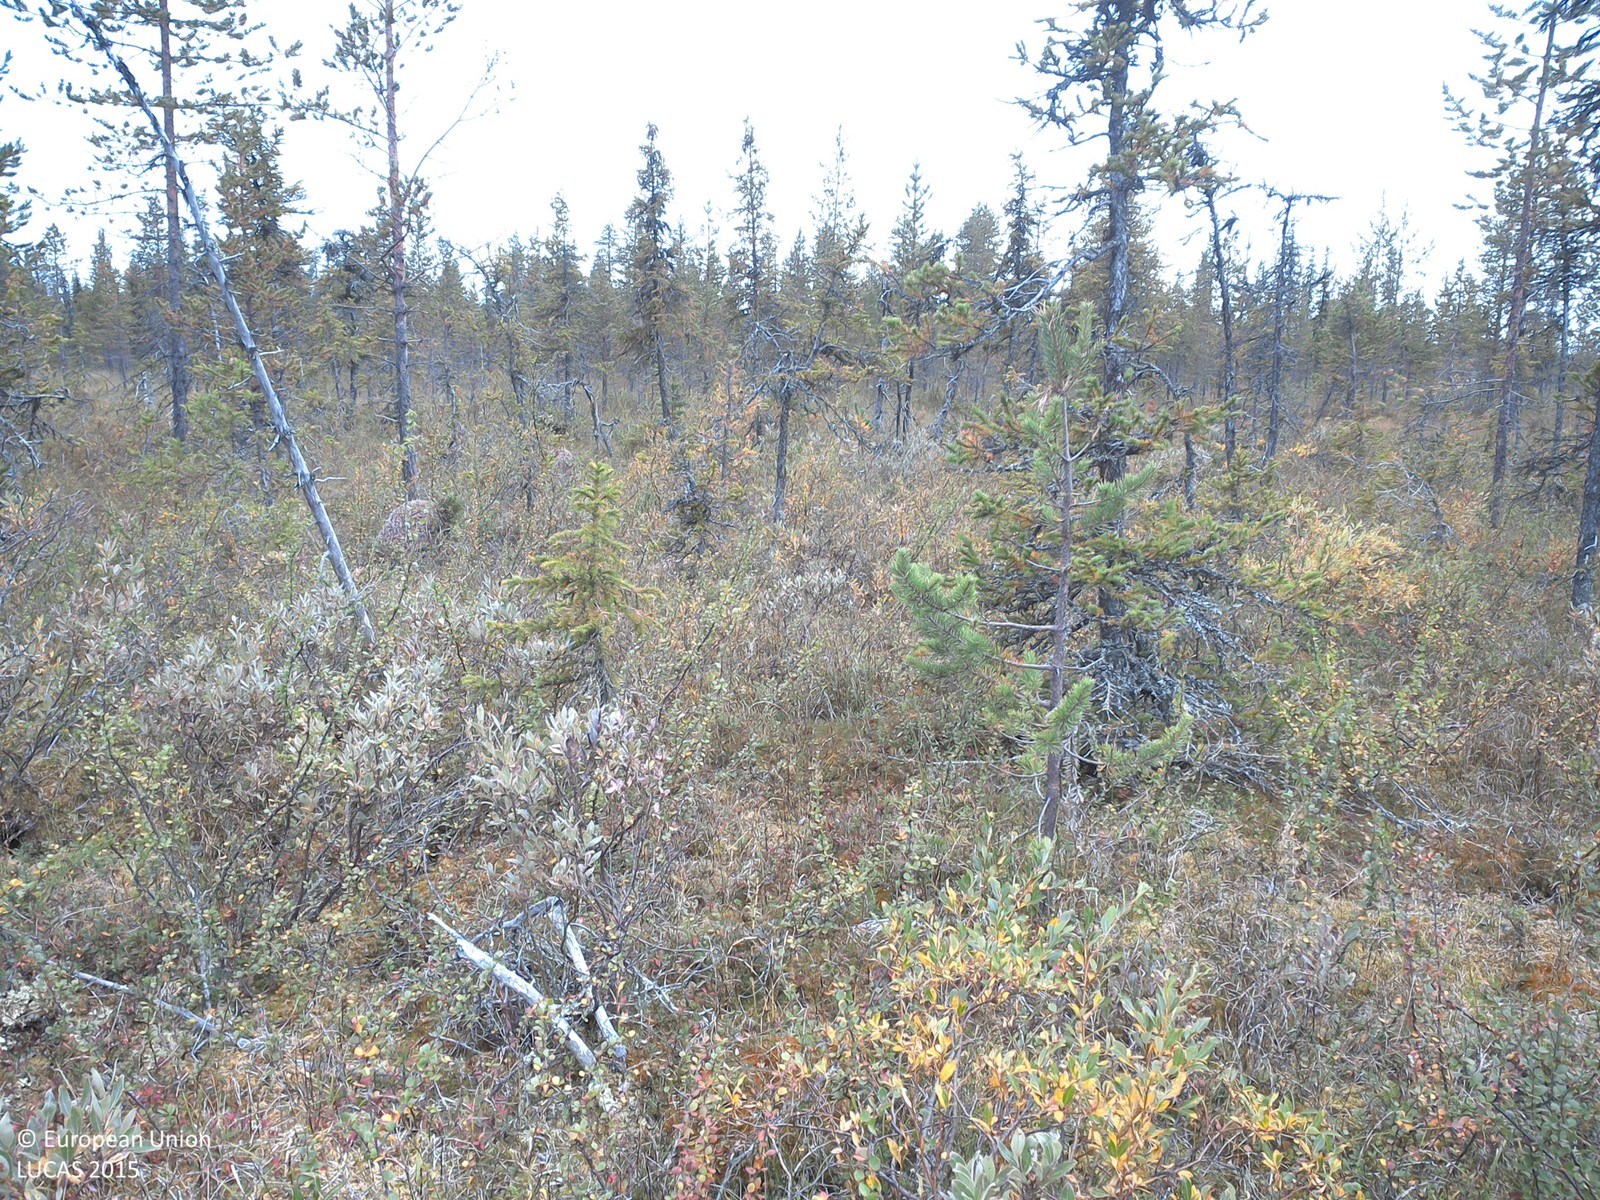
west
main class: Woodland
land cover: Spruce dominated coniferous woodland
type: boreal forest
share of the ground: 10 - 25 %
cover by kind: shrubs 65 %, lichens and mosses 20 %, coniferous forest trees 15 %
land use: Semi-natural and natural areas not in use
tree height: > 5 m
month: August
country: SE
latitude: 67.8384
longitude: 21.3227
